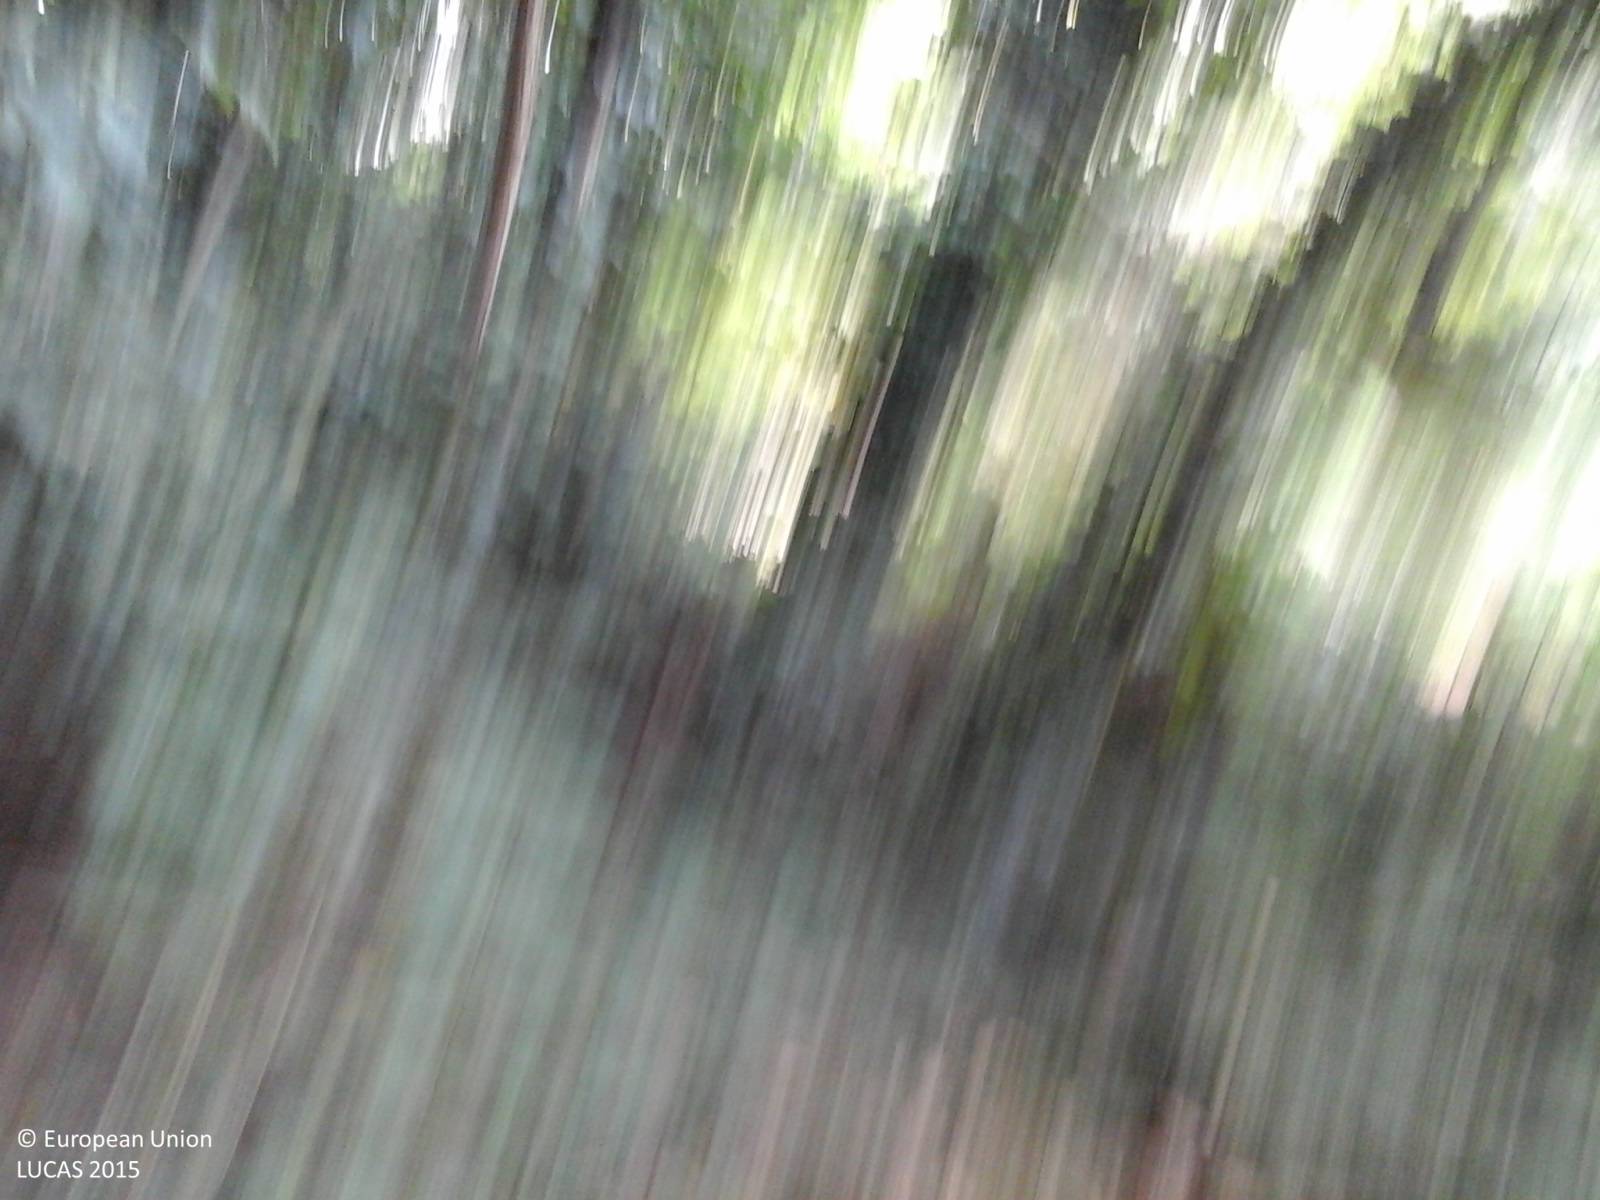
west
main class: Woodland
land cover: Broadleaved woodland
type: thermophilous deciduous forest
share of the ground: > 75 %
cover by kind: broadleaved forest trees 75 %, shrubs 25 %
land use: Forestry
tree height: > 5 m
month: October
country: IT
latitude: 43.2844
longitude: 10.5775
